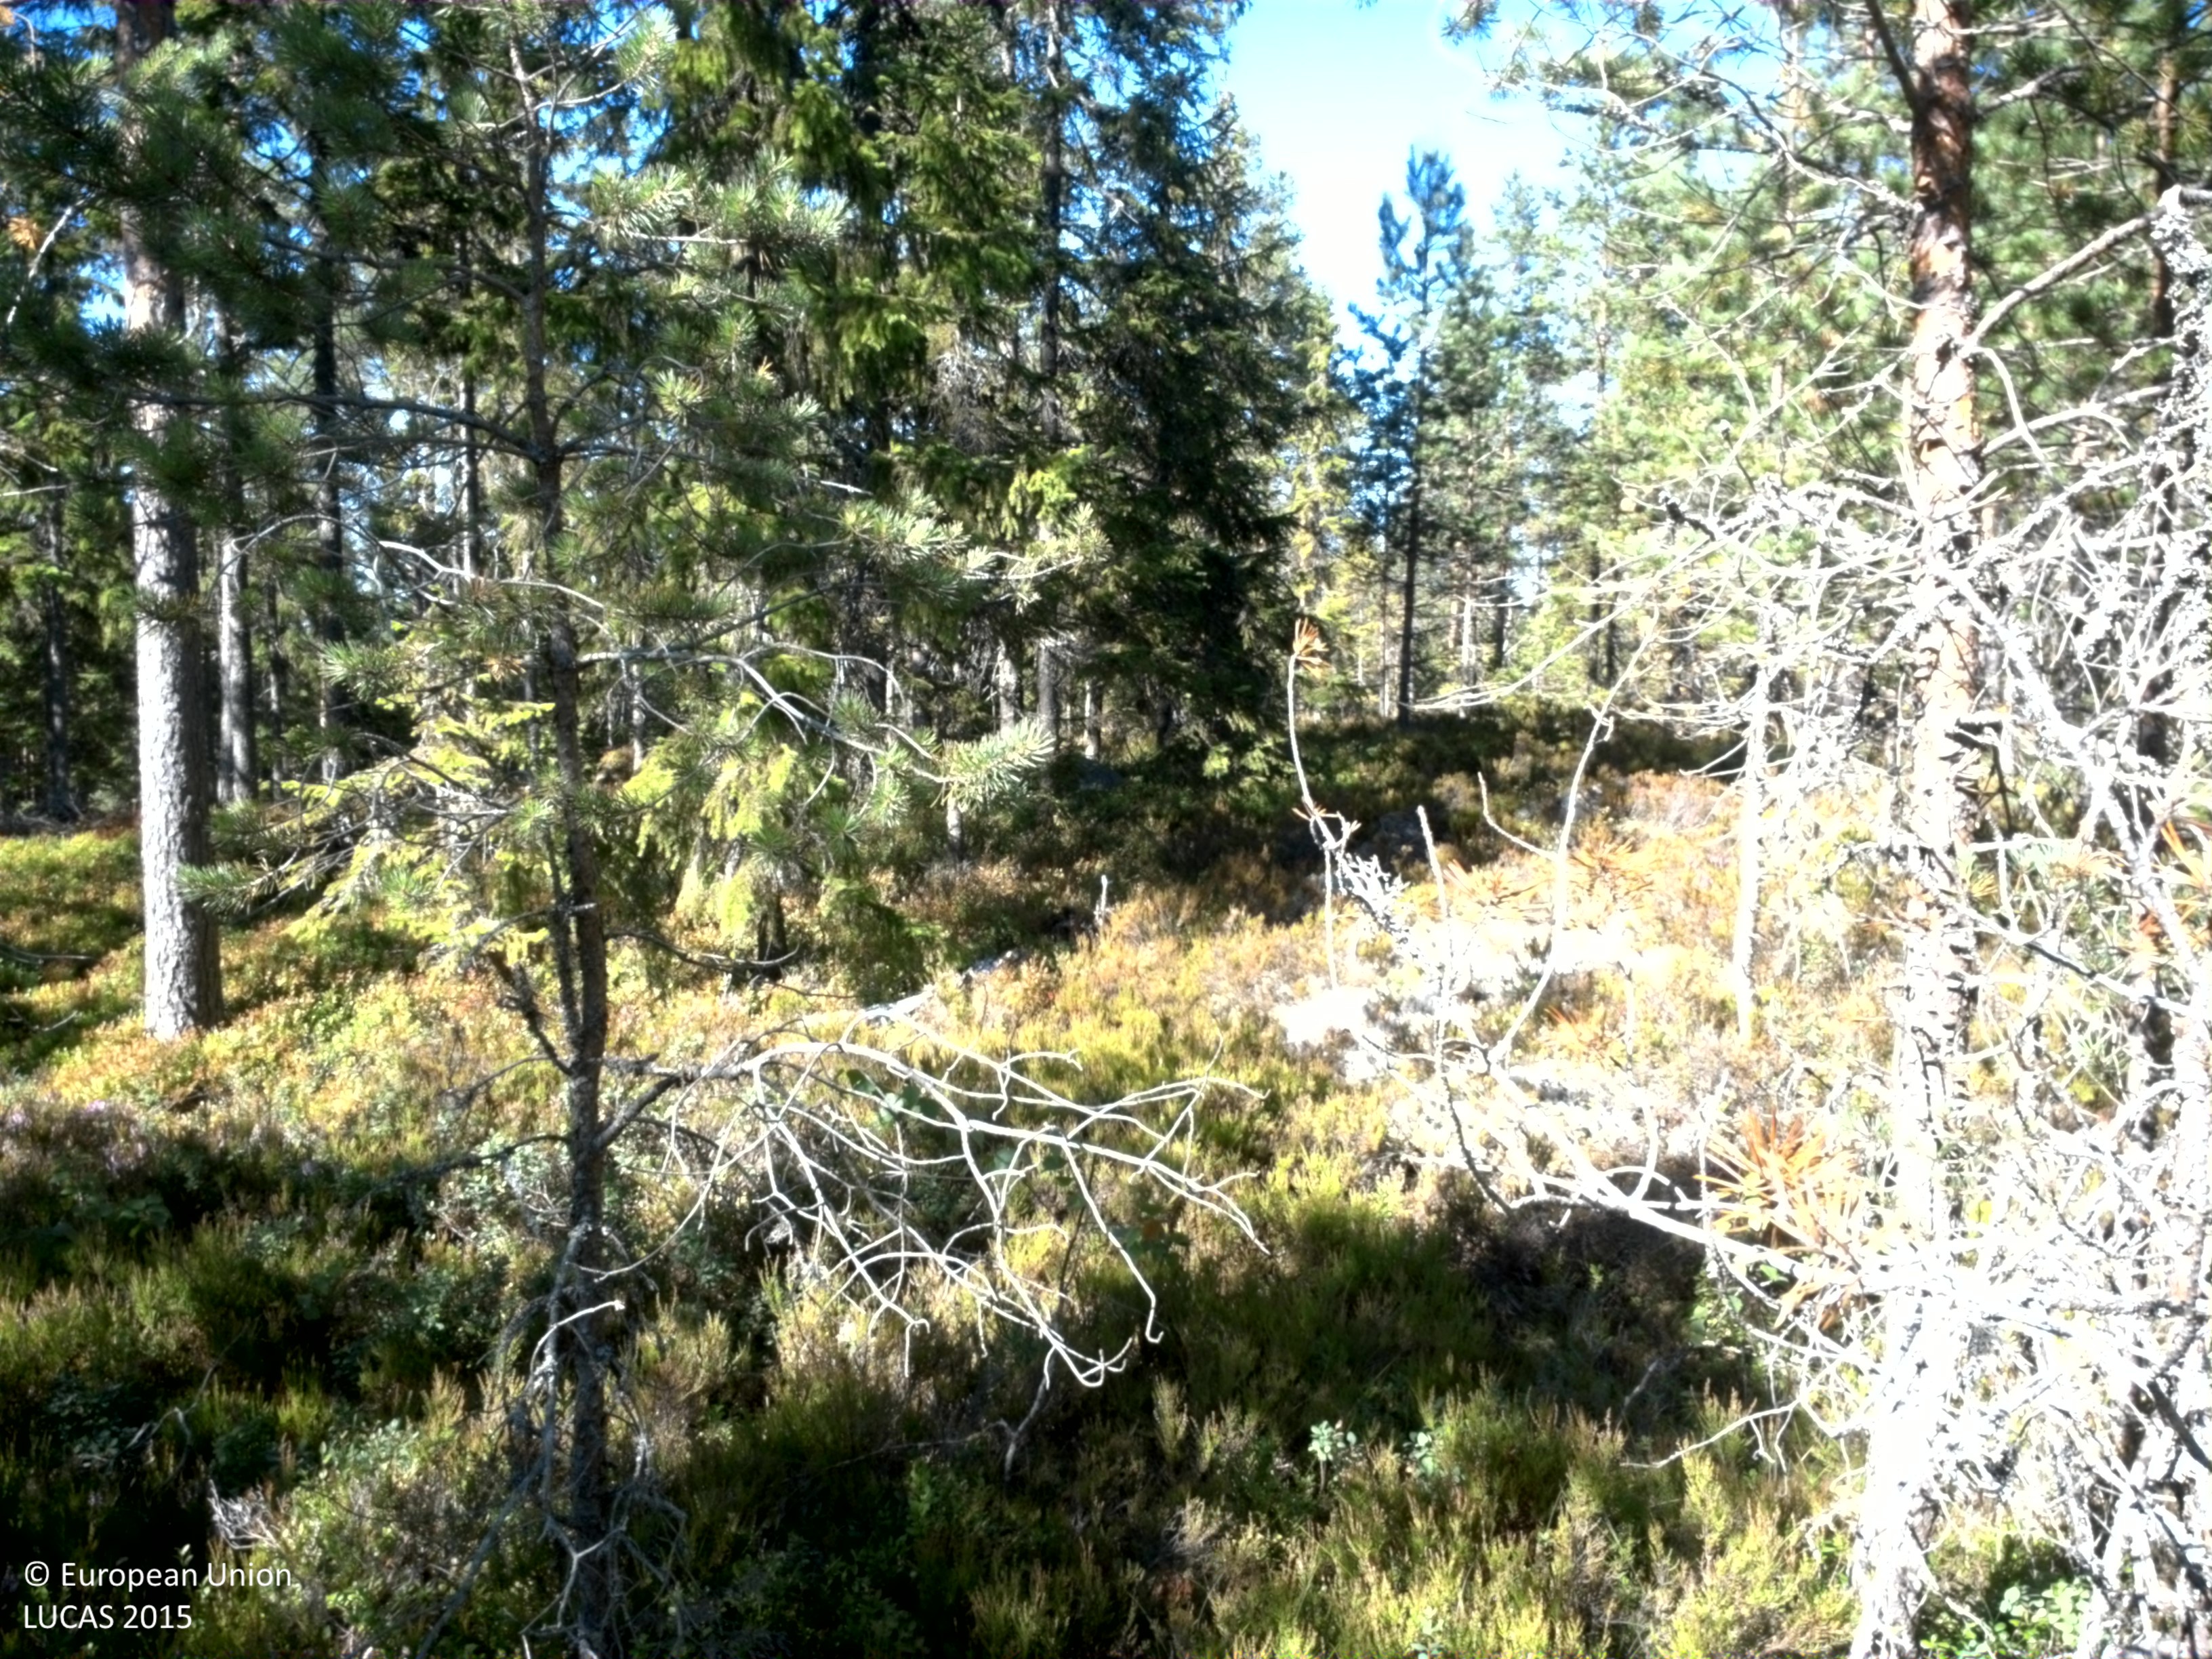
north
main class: Woodland
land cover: Other coniferous woodland
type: boreal forest
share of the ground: 50 - 75 %
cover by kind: coniferous forest trees 60 %, shrubs 30 %, broadleaved forest trees 5 %, lichens and mosses 5 %
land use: Forestry
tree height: > 5 m
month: August
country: SE
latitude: 59.9391
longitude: 14.1601
